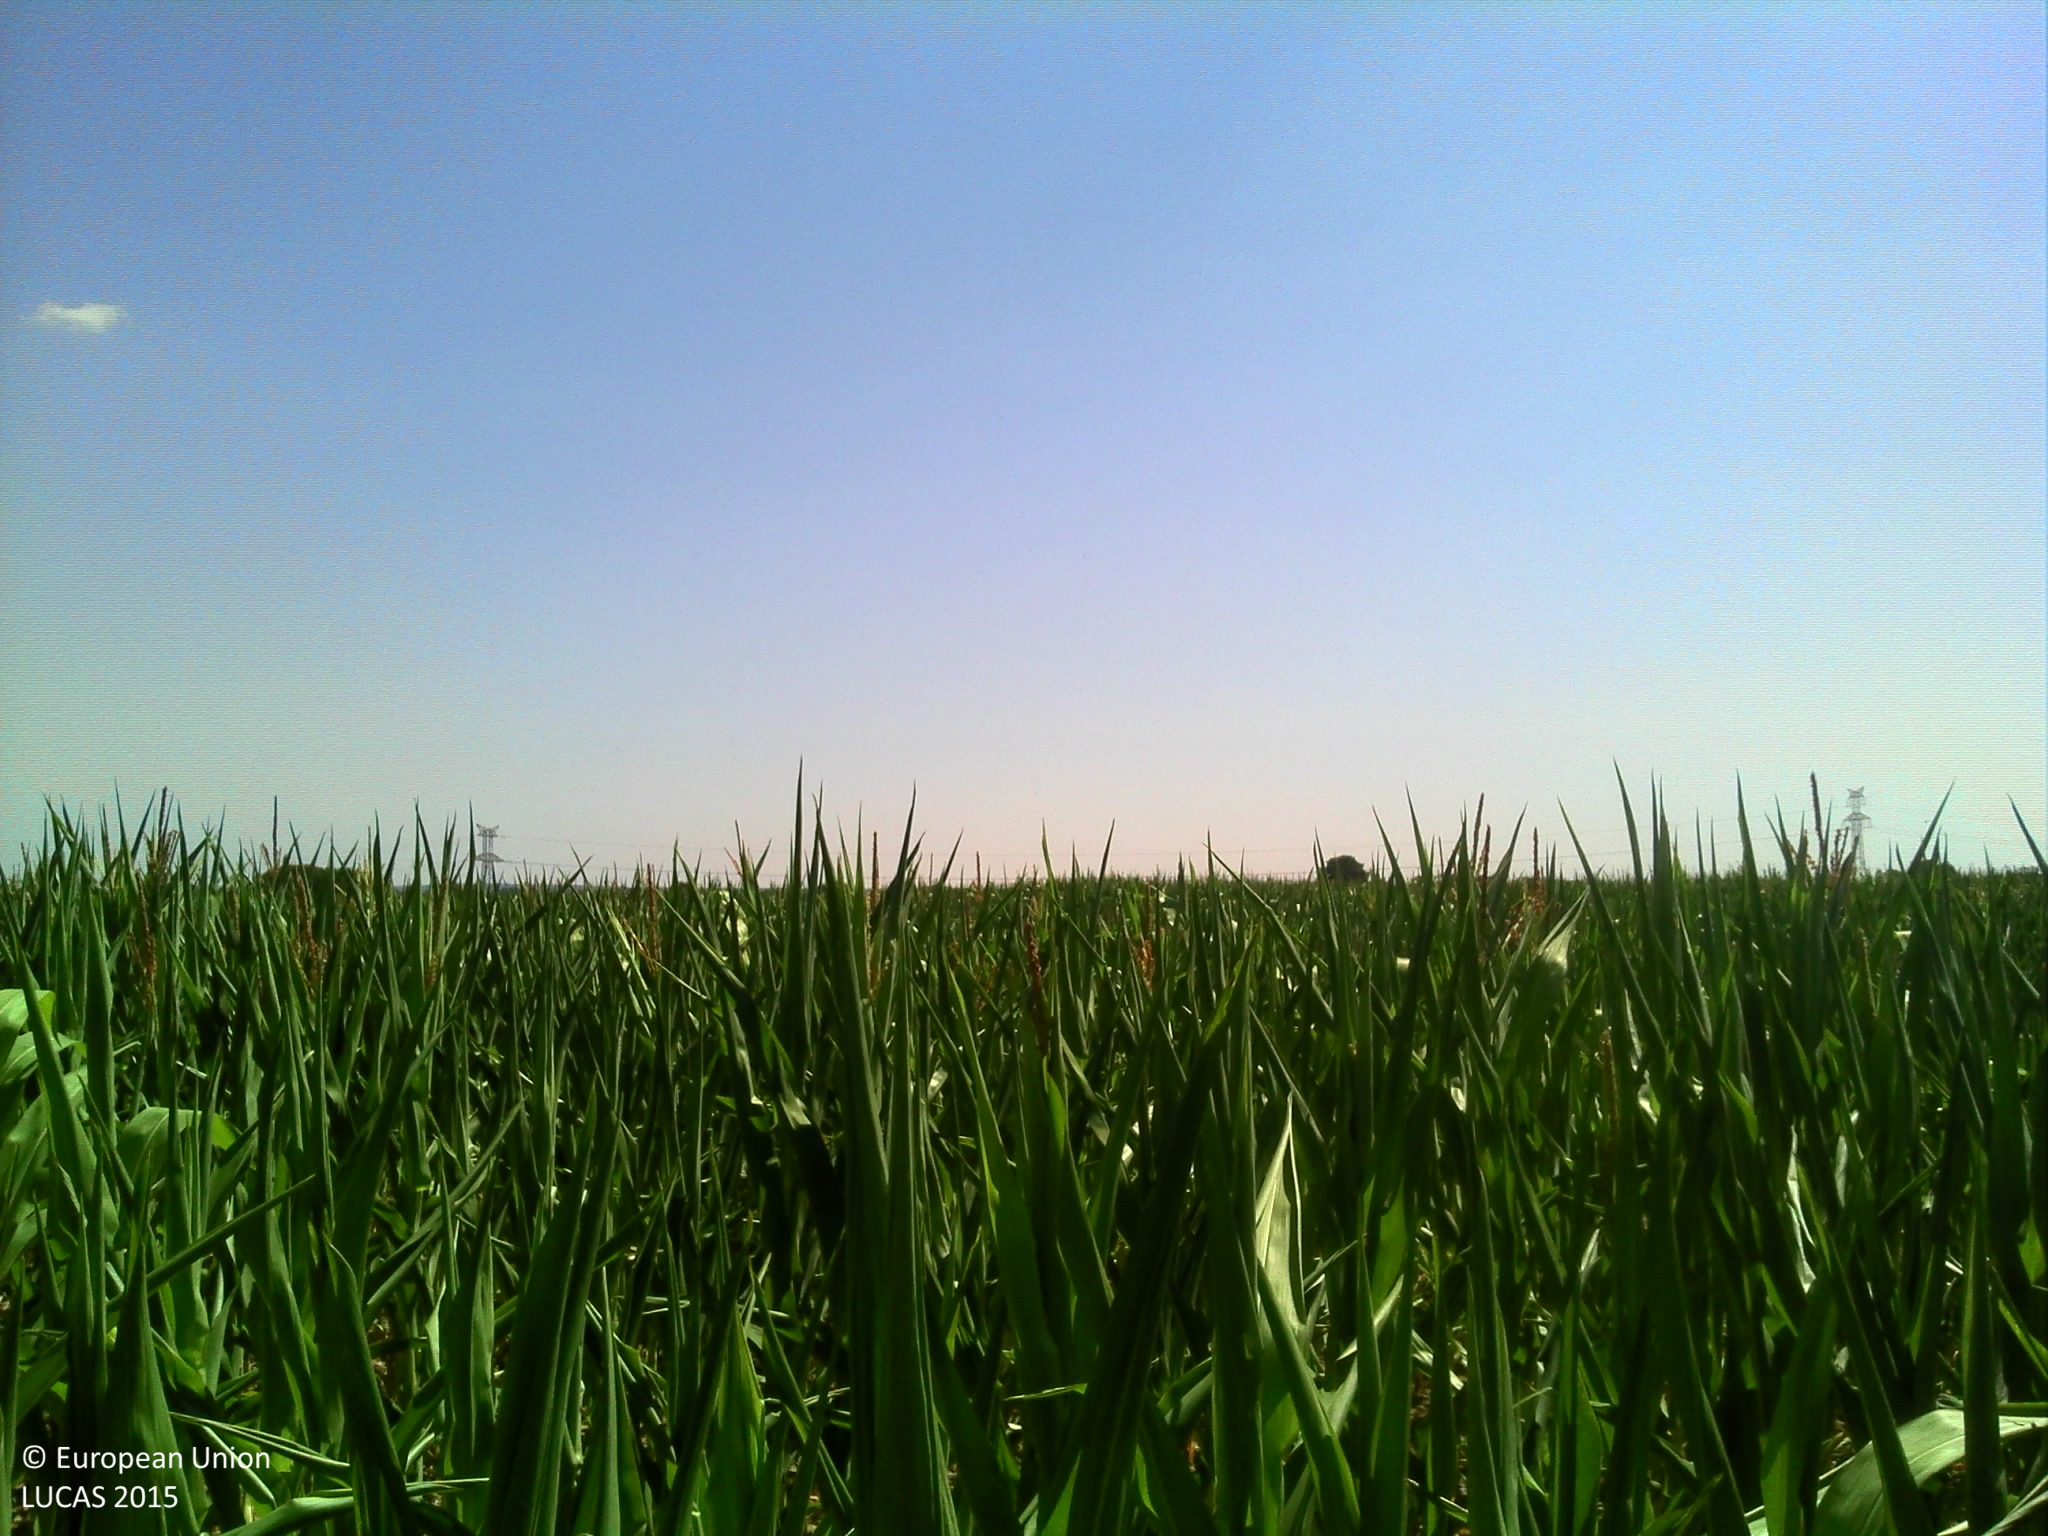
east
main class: Cropland
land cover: Maize
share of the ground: > 75 %
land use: Agriculture (excluding fallow land and kitchen gardens)
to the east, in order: Maize
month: July
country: FR
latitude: 47.8850
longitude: 0.7114
